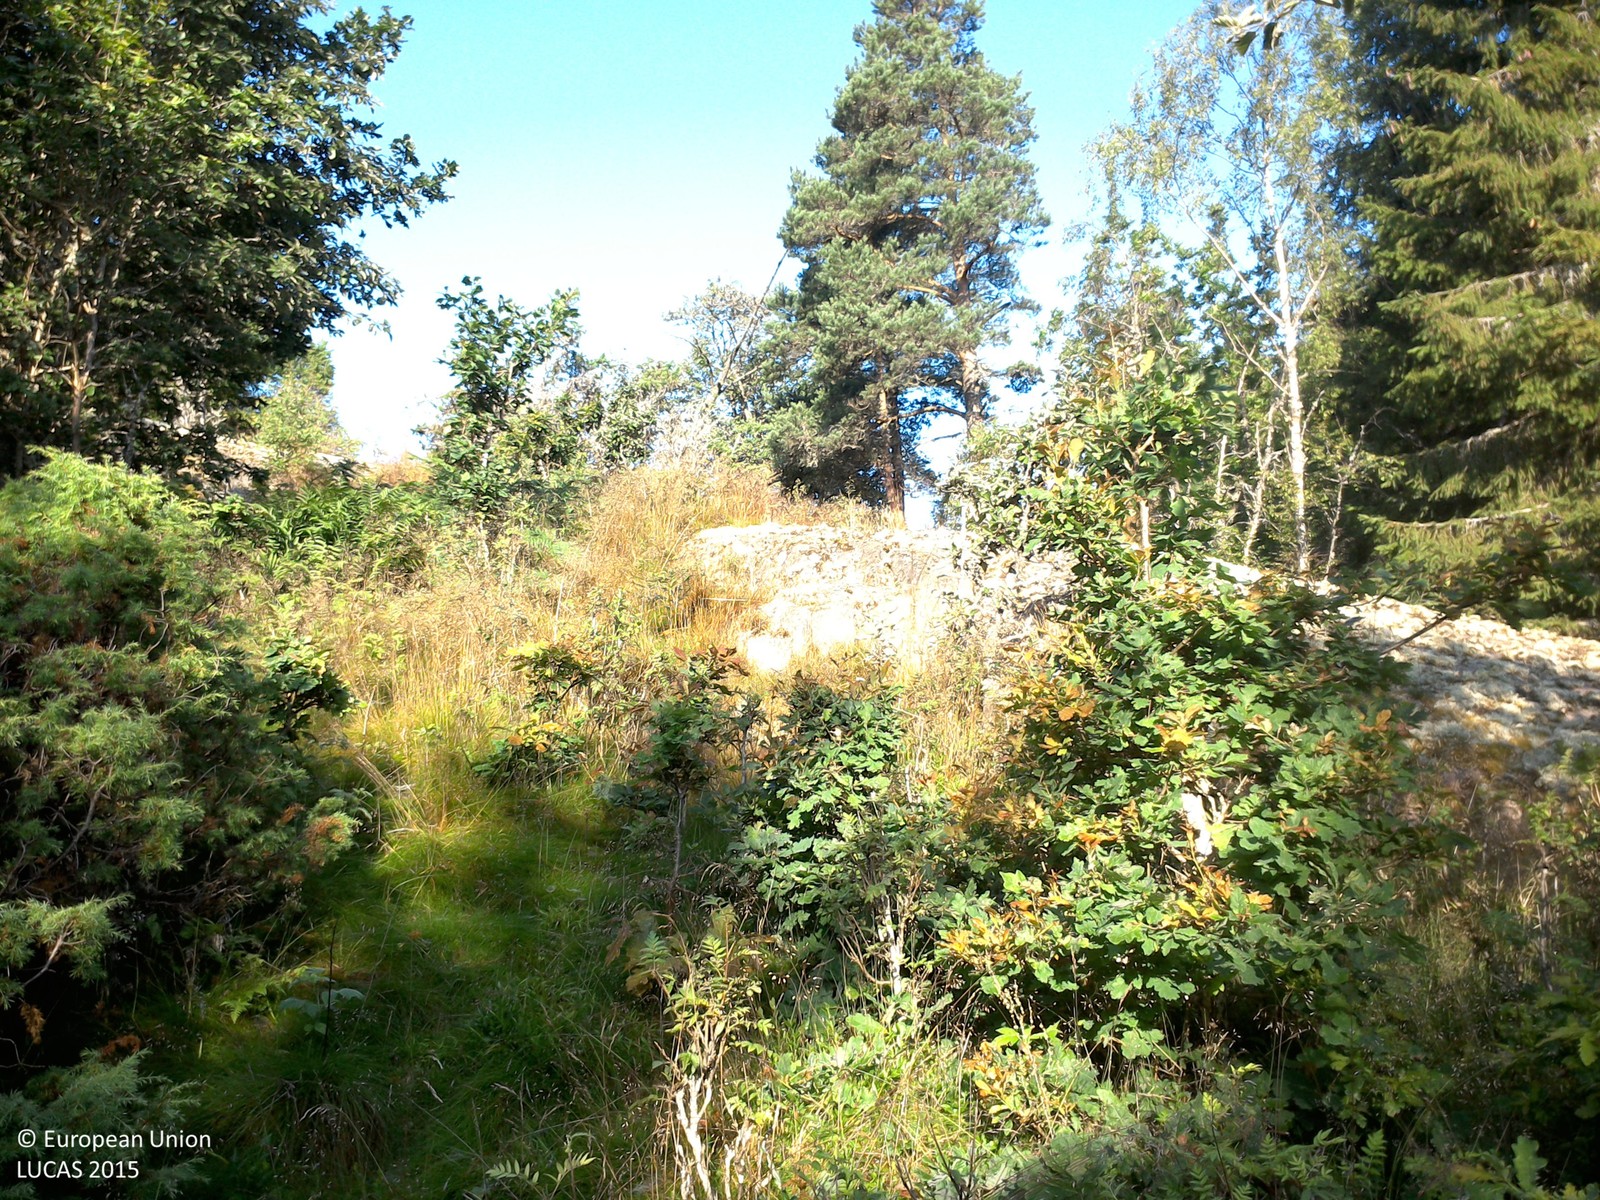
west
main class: Woodland
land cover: Broadleaved woodland
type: boreal forest
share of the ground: 25 - 50 %
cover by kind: herbaceous plants 75 %, broadleaved forest trees 20 %, shrubs 5 %
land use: Forestry
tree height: > 5 m
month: July
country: SE
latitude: 58.0393
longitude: 14.9237
